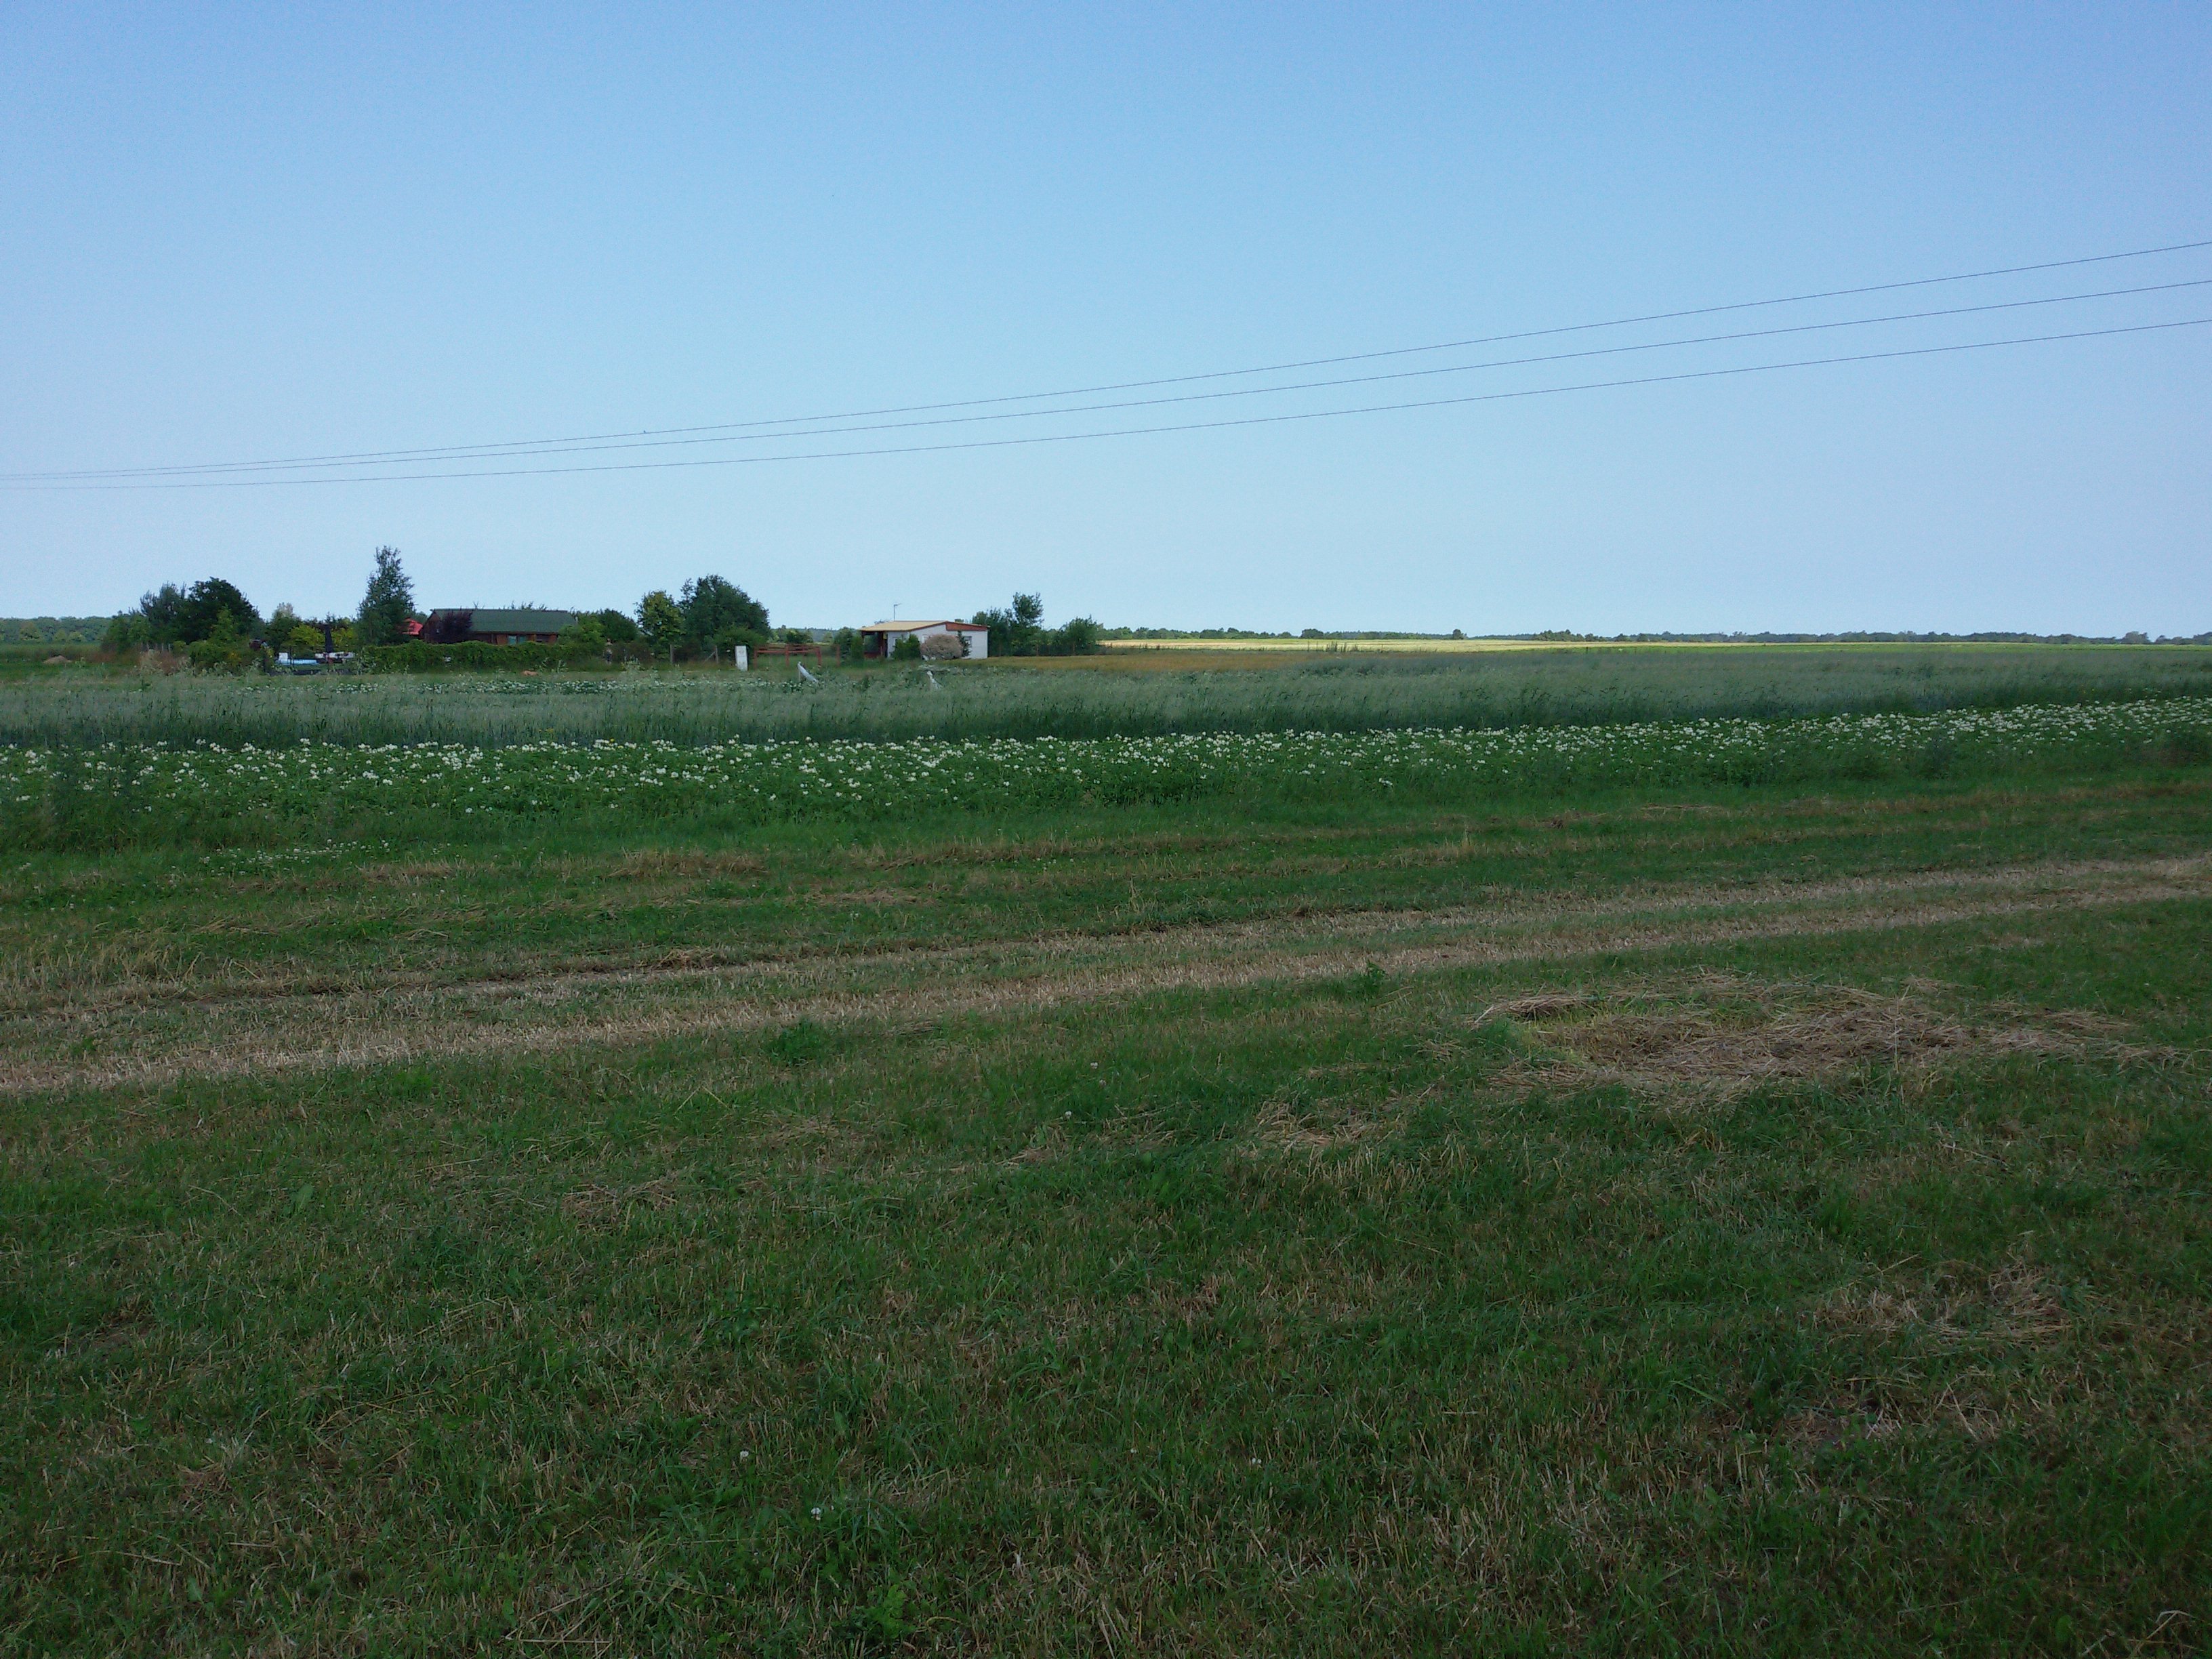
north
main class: Grassland
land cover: Grassland without tree/shrub cover
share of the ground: > 75 %
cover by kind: herbaceous plants 100 %
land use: Agriculture (excluding fallow land and kitchen gardens)
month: July
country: PL
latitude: 54.2145
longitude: 15.8770
